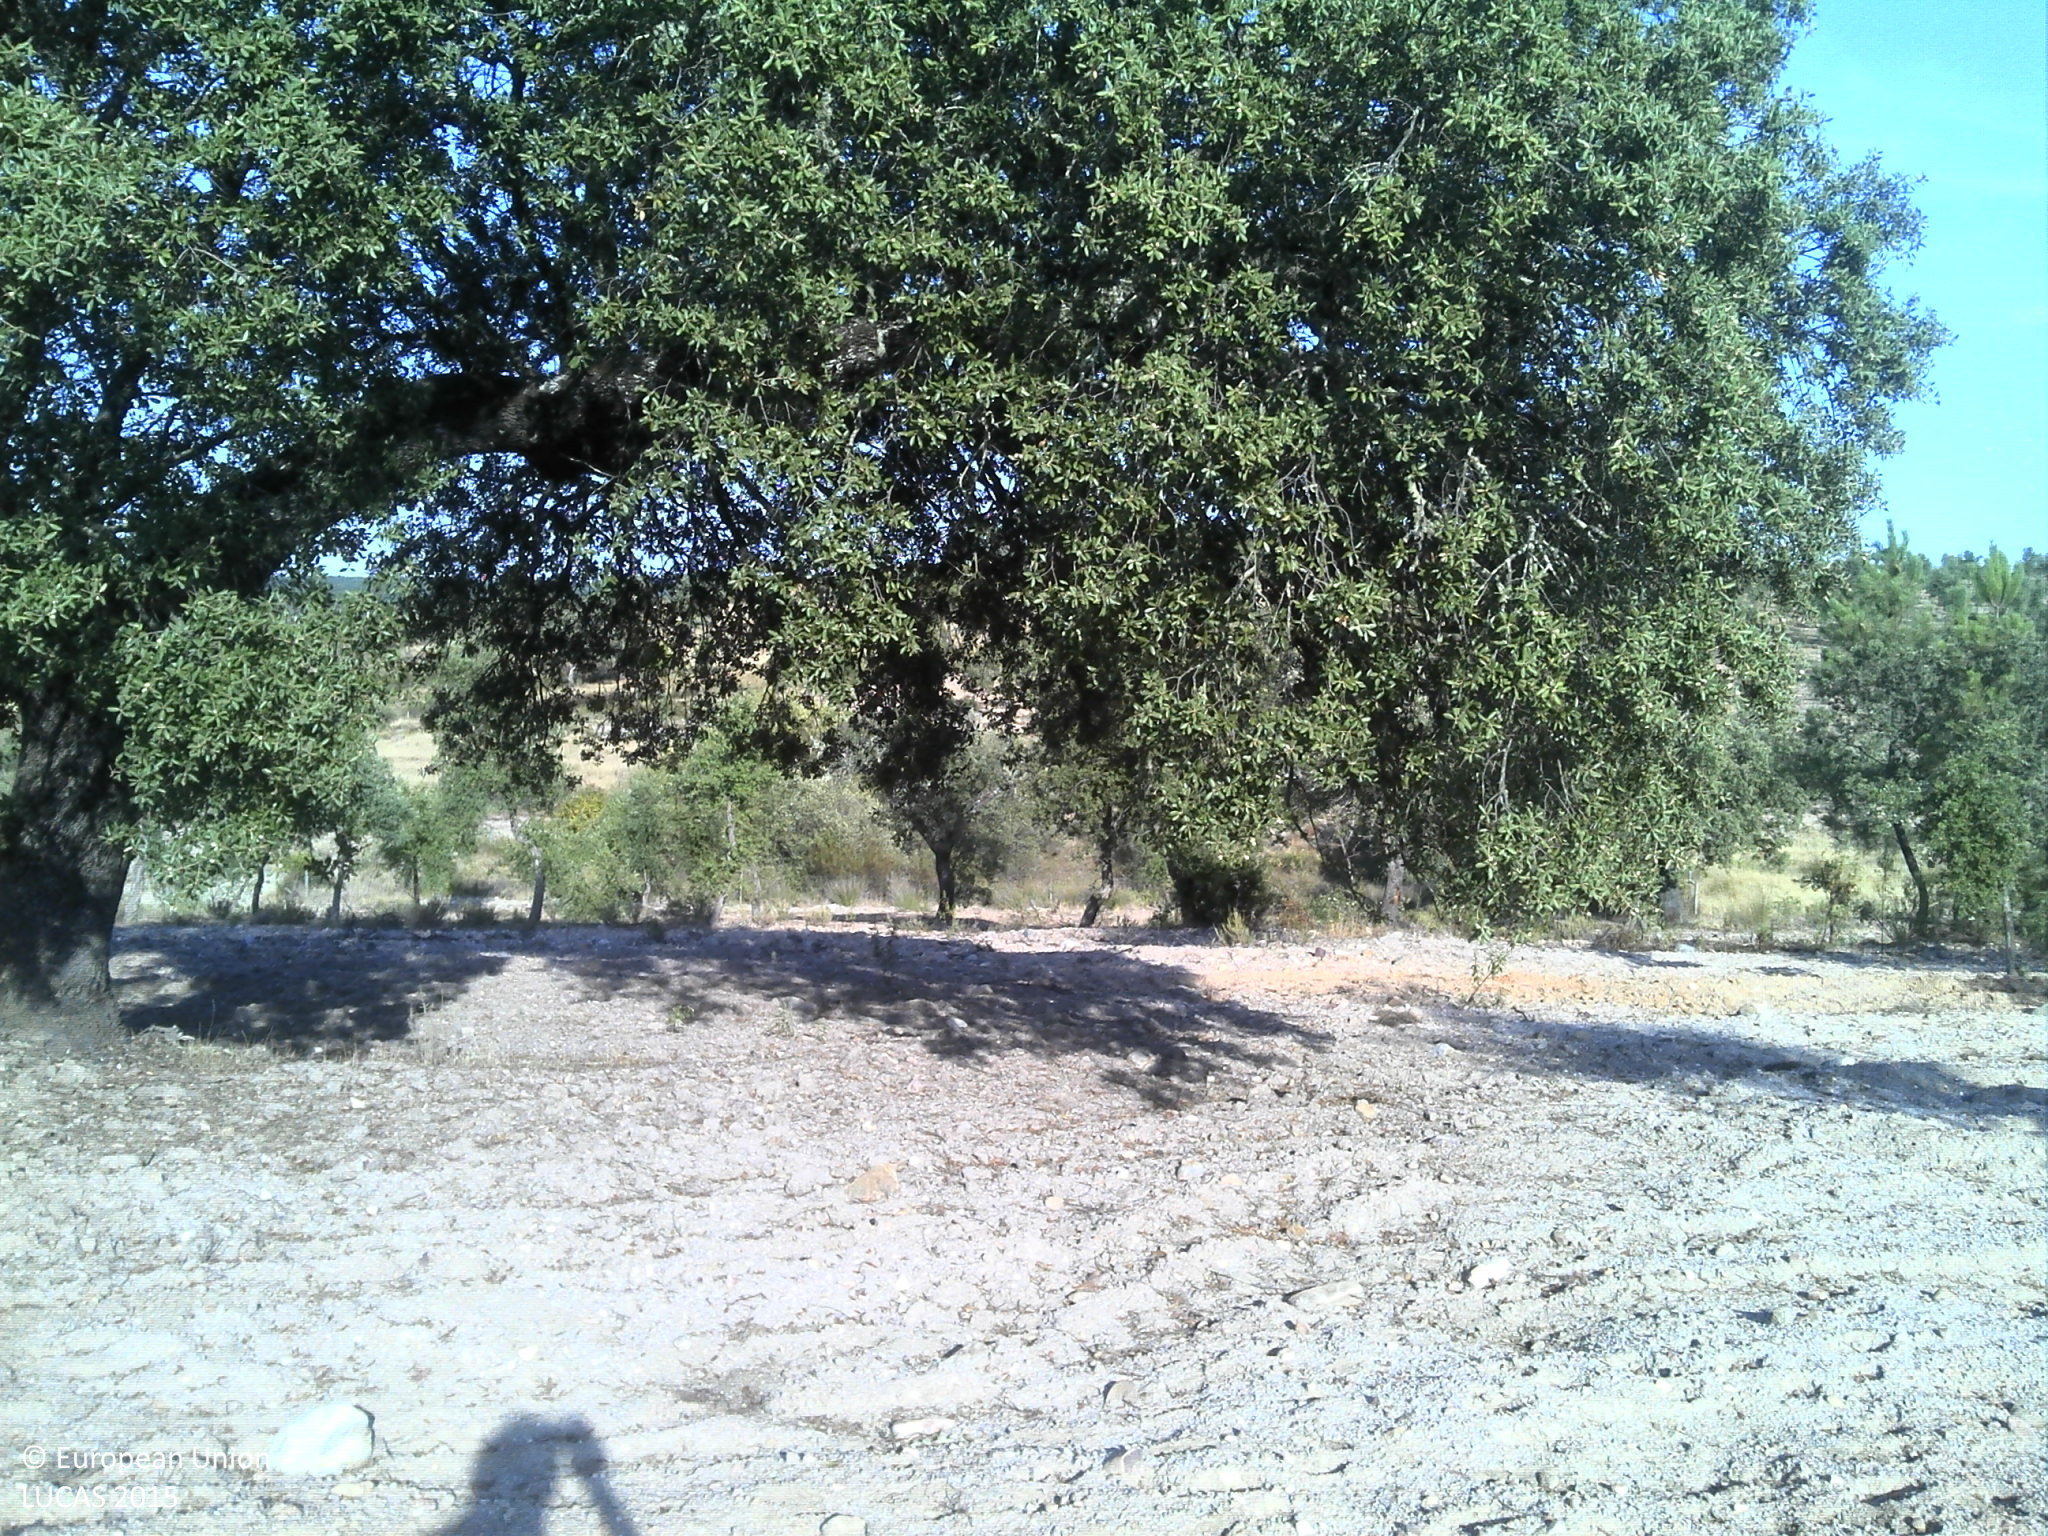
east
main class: Woodland
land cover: Broadleaved woodland
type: broadleaved evergreen forest
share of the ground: 10 - 25 %
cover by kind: unconsolidated bare surface 65 %, broadleaved forest trees 25 %, shrubs 5 %, herbaceous plants 5 %
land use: Forestry
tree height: < 5 m
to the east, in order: Broadleaved woodland; Grass margins; Ditches and canals; Grassland without tree/shrub cover; Shruby margins; Fences; Shruby margins; Grassland without tree/shrub cover; Rivers and streams; Grassland without tree/shrub cover
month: July
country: PT
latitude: 39.7121
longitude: -7.5125
